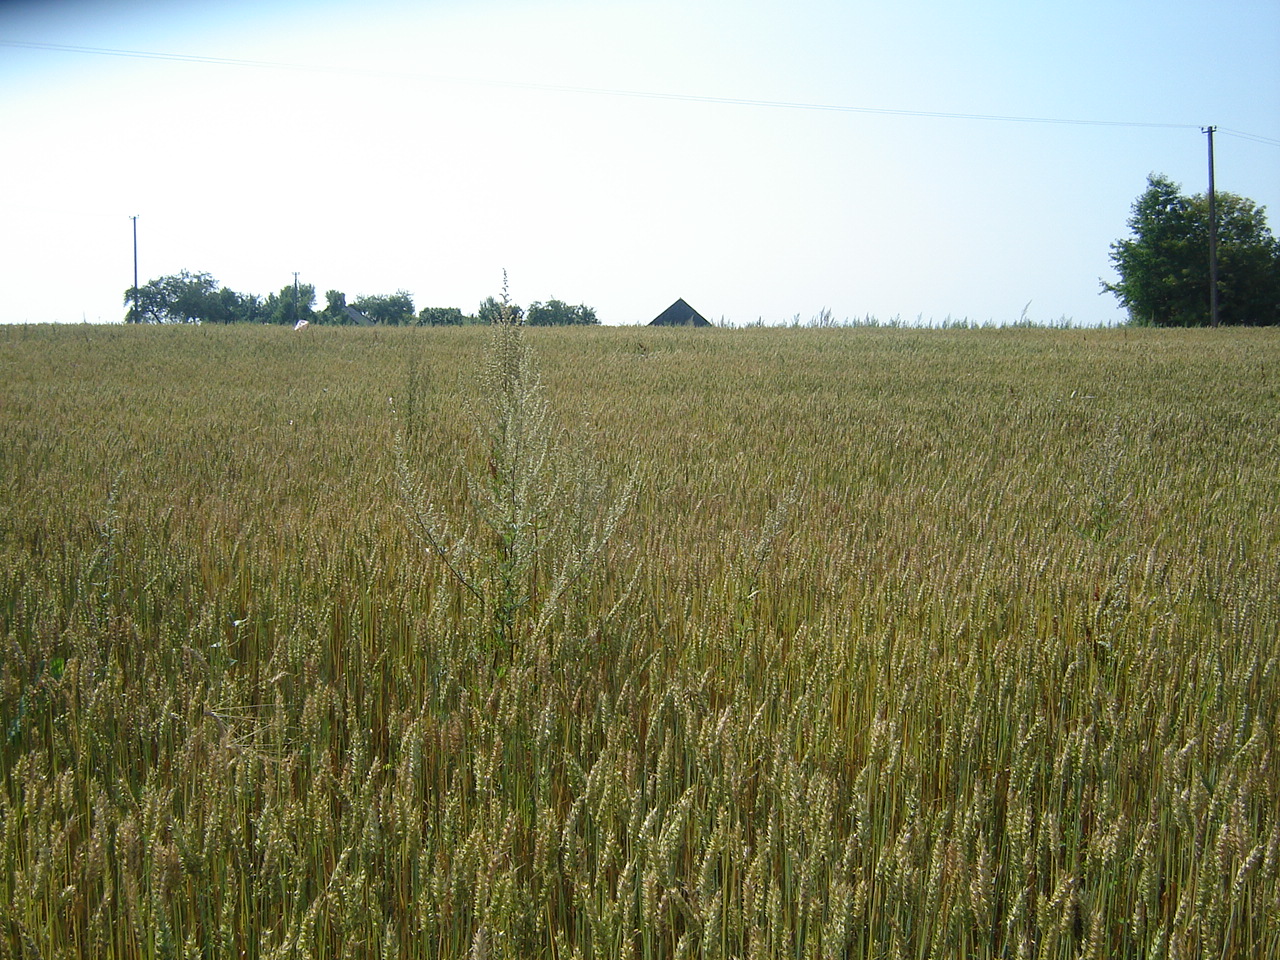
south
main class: Grassland
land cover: Grassland with sparse tree/shrub cover
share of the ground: > 75 %
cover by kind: herbaceous plants 95 %, broadleaved forest trees 5 %
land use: Residential
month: August
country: LT
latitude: 55.0740
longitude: 25.0400
